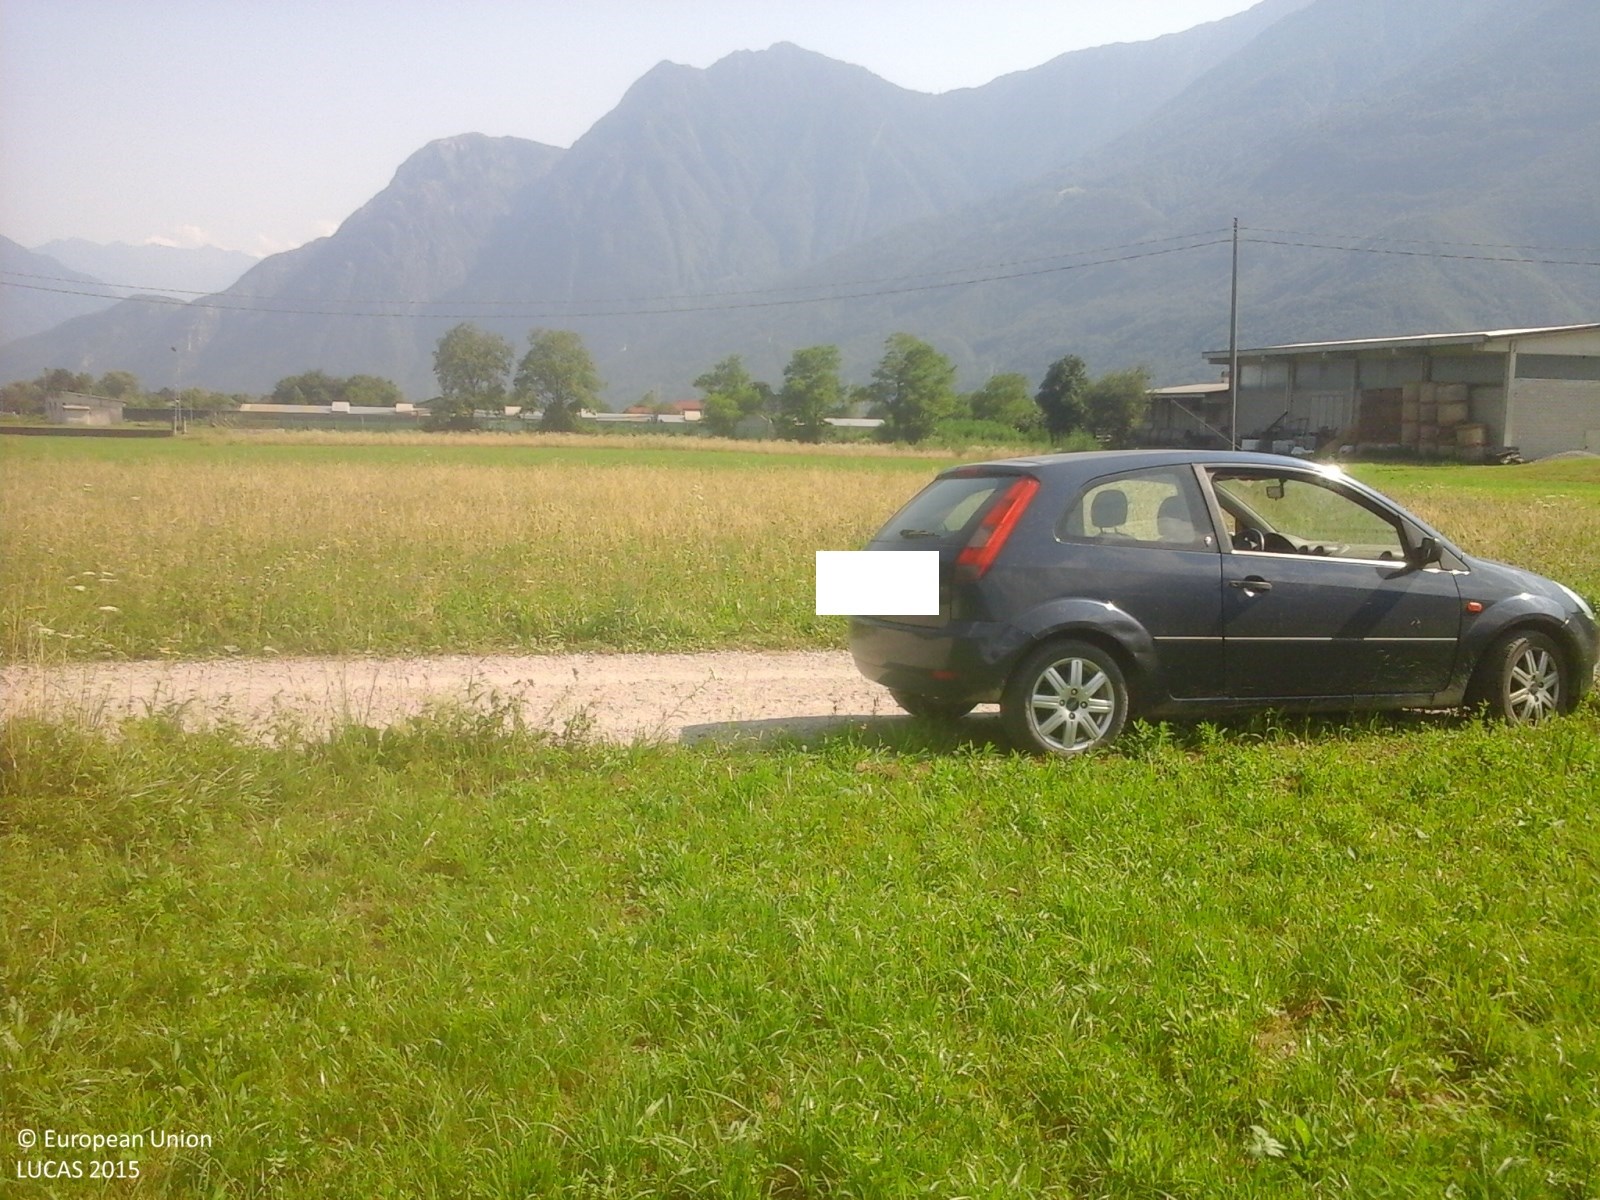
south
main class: Grassland
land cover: Grassland without tree/shrub cover
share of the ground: > 75 %
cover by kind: herbaceous plants 100 %
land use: Agriculture (excluding fallow land and kitchen gardens)
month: July
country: IT
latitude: 46.2774
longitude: 9.3909
